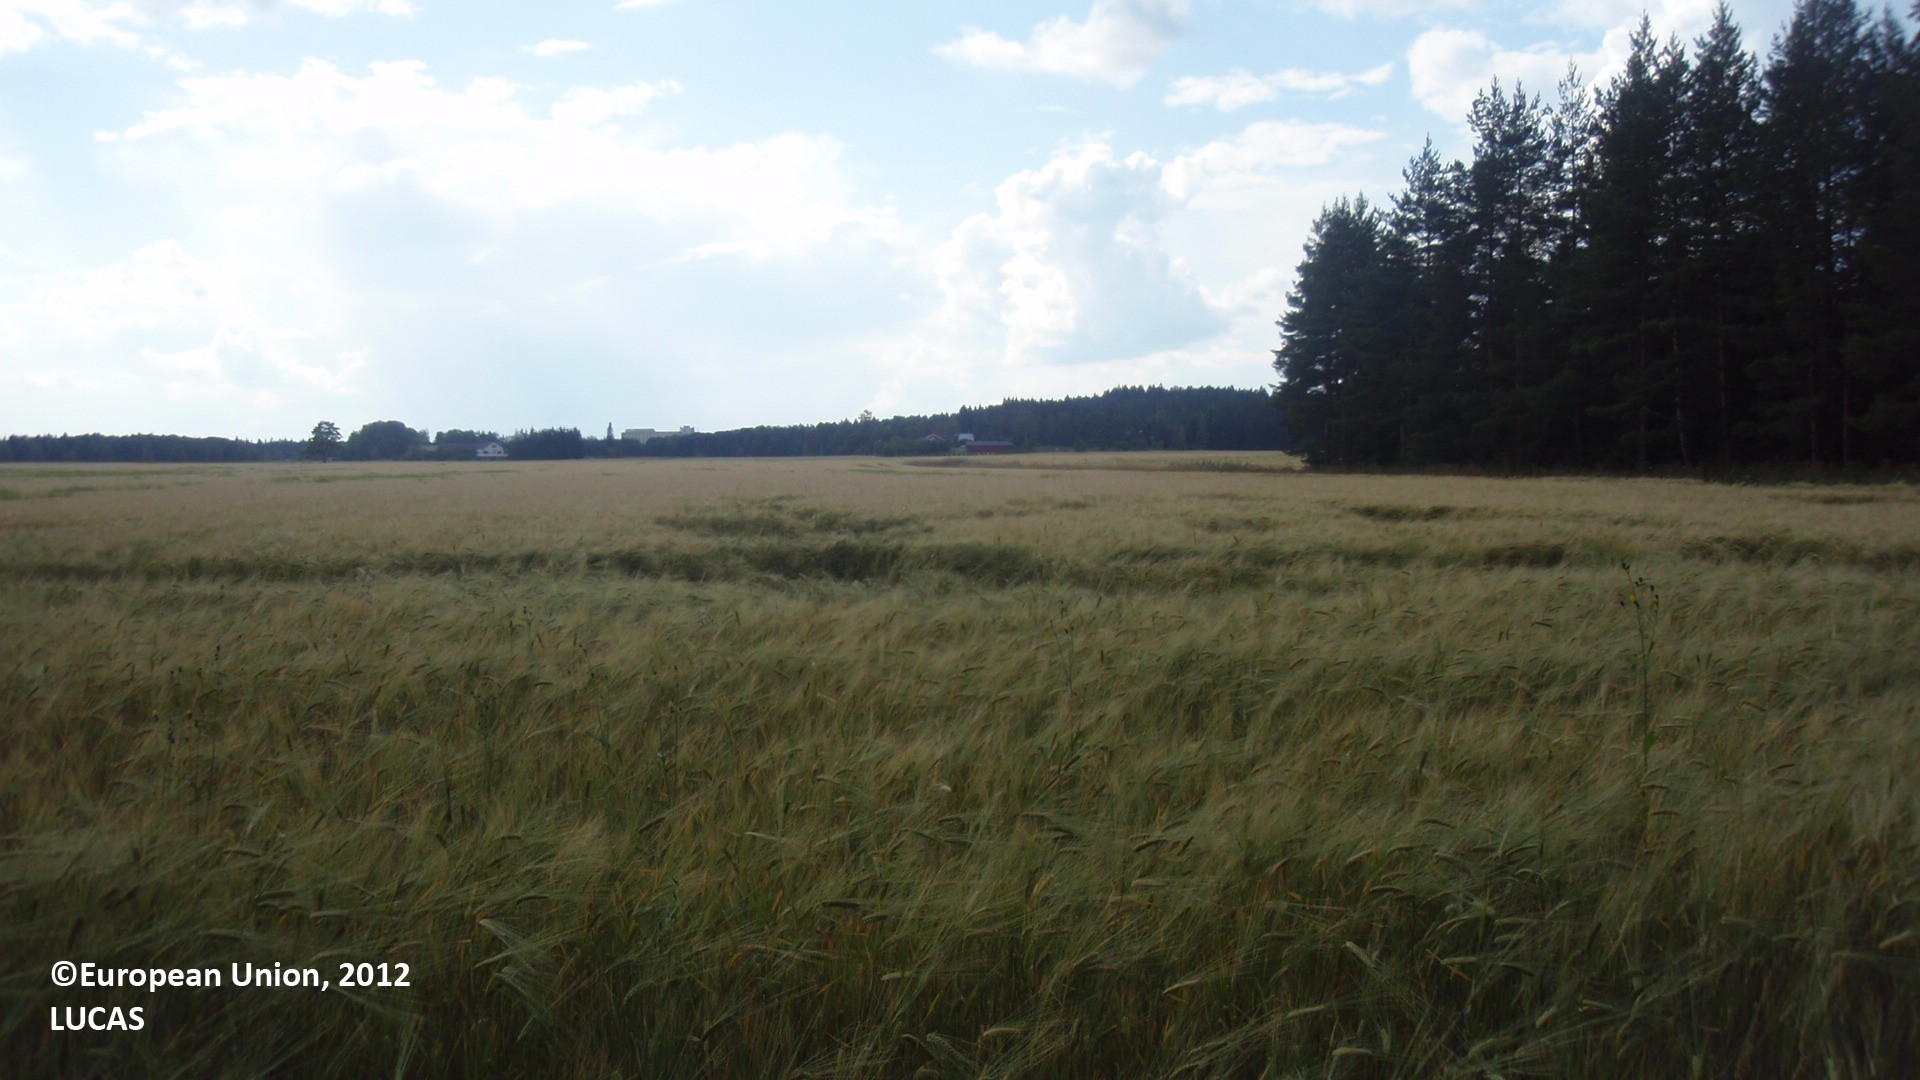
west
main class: Cropland
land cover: Barley
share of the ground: > 75 %
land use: Agriculture (excluding fallow land and kitchen gardens)
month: August
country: FI
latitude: 60.8627
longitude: 26.6352
